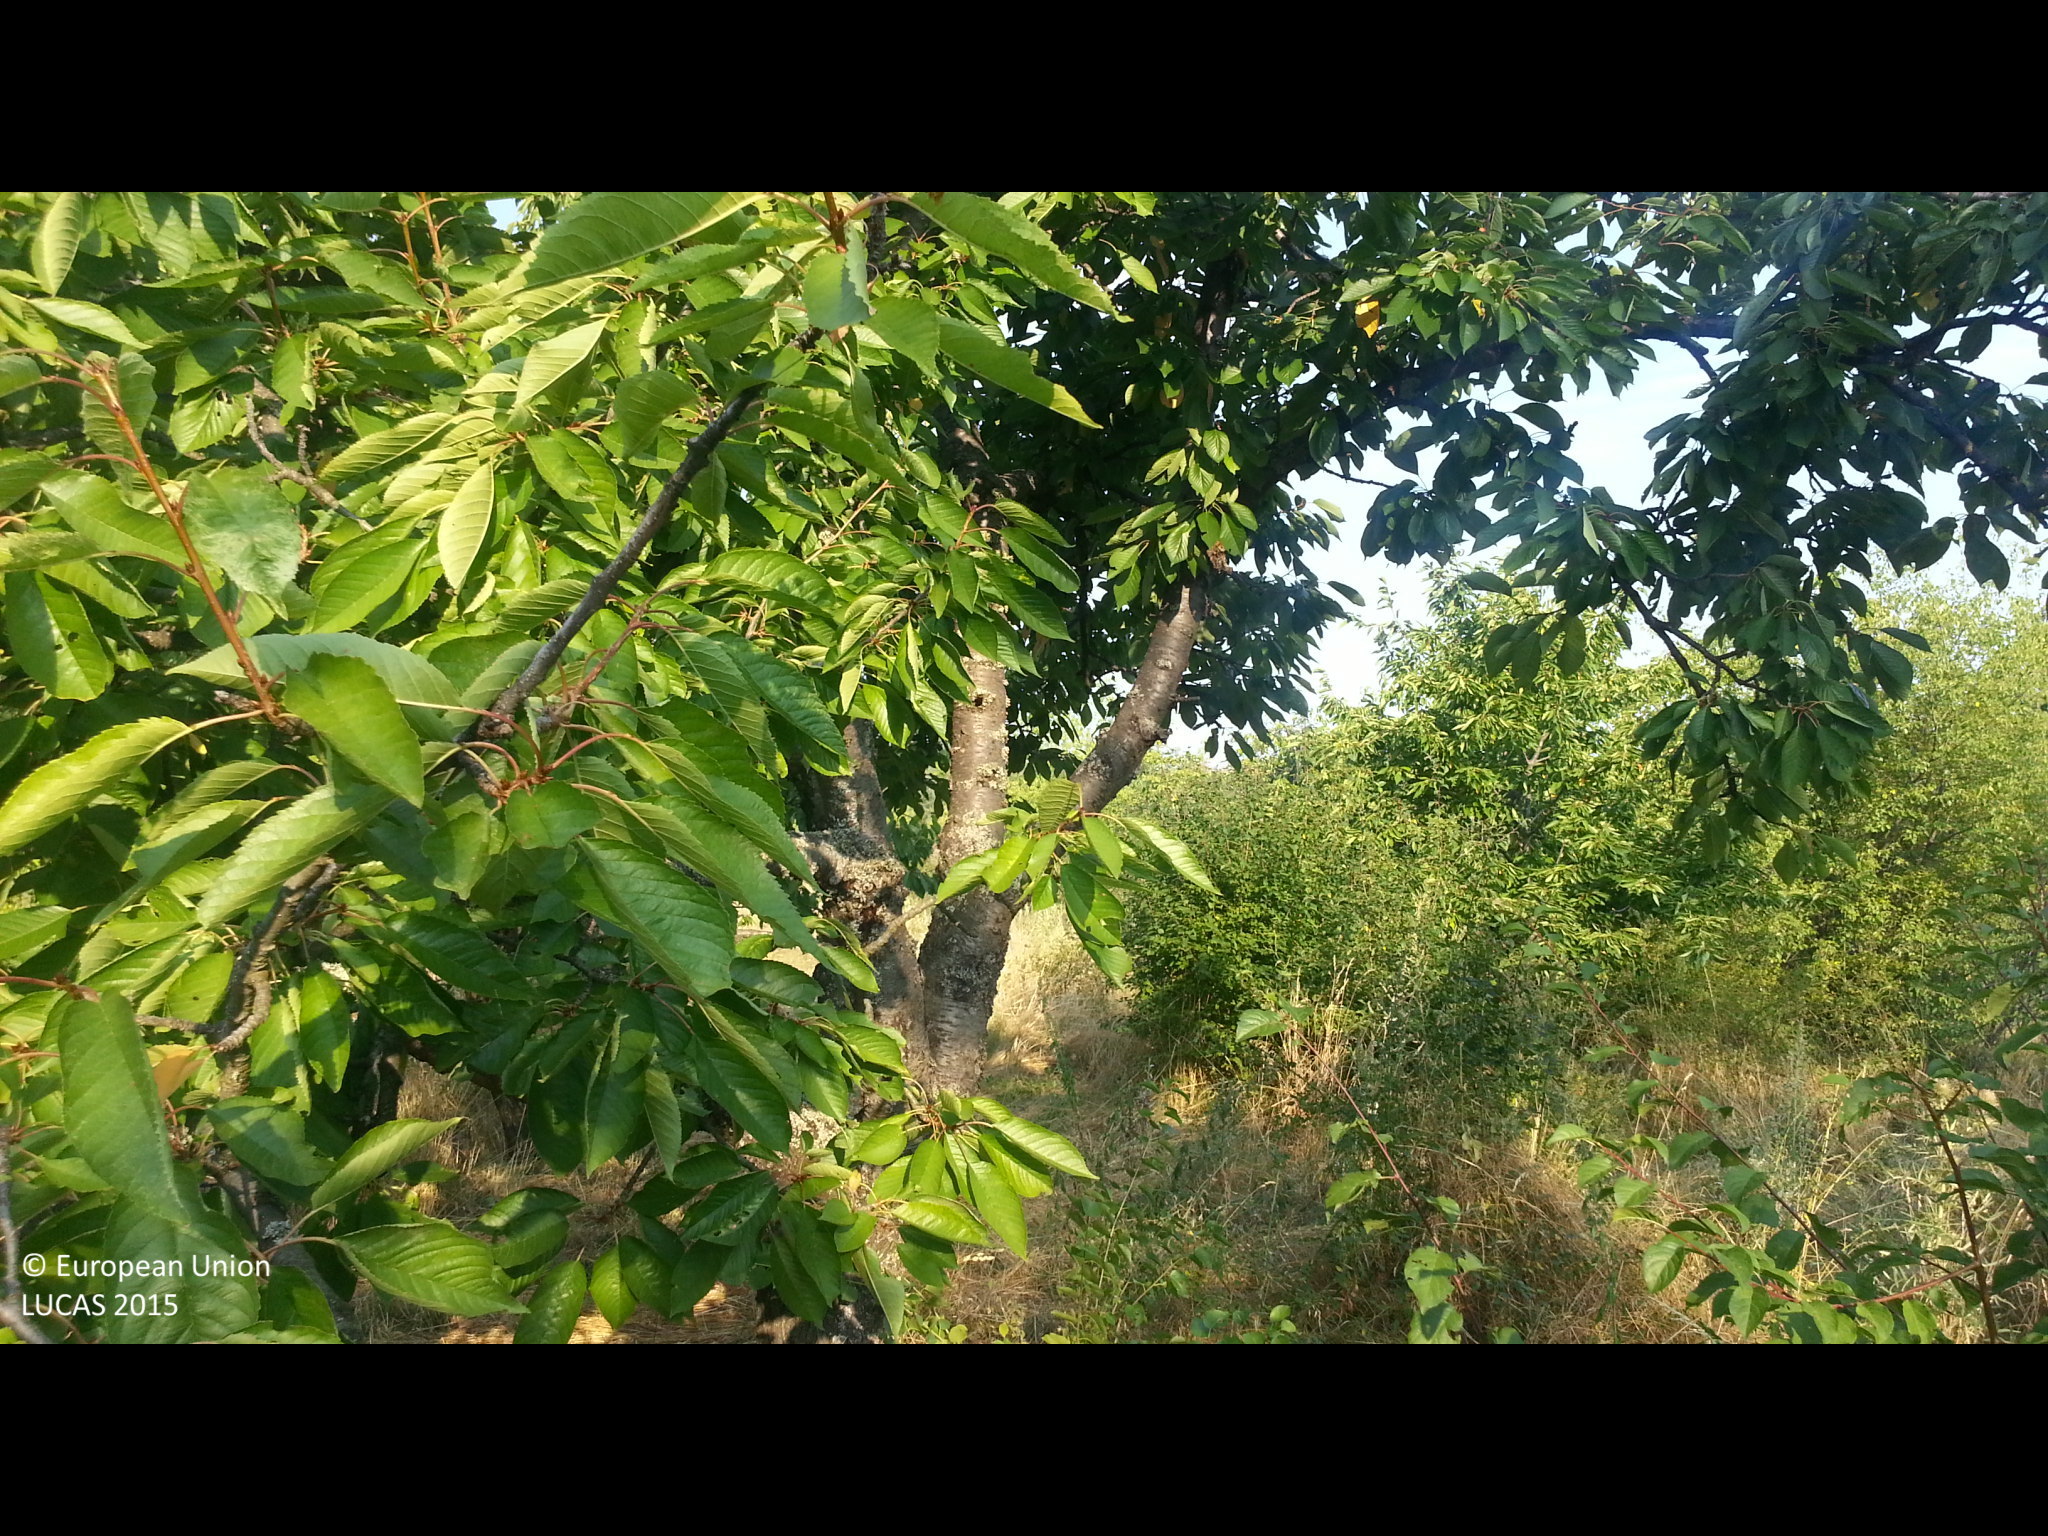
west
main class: Cropland
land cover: Cherry fruit
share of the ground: > 75 %
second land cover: Spontaneously vegetated surfaces
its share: > 75 %
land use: Agriculture (excluding fallow land and kitchen gardens)
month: August
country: BG
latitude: 42.4025
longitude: 22.6704
